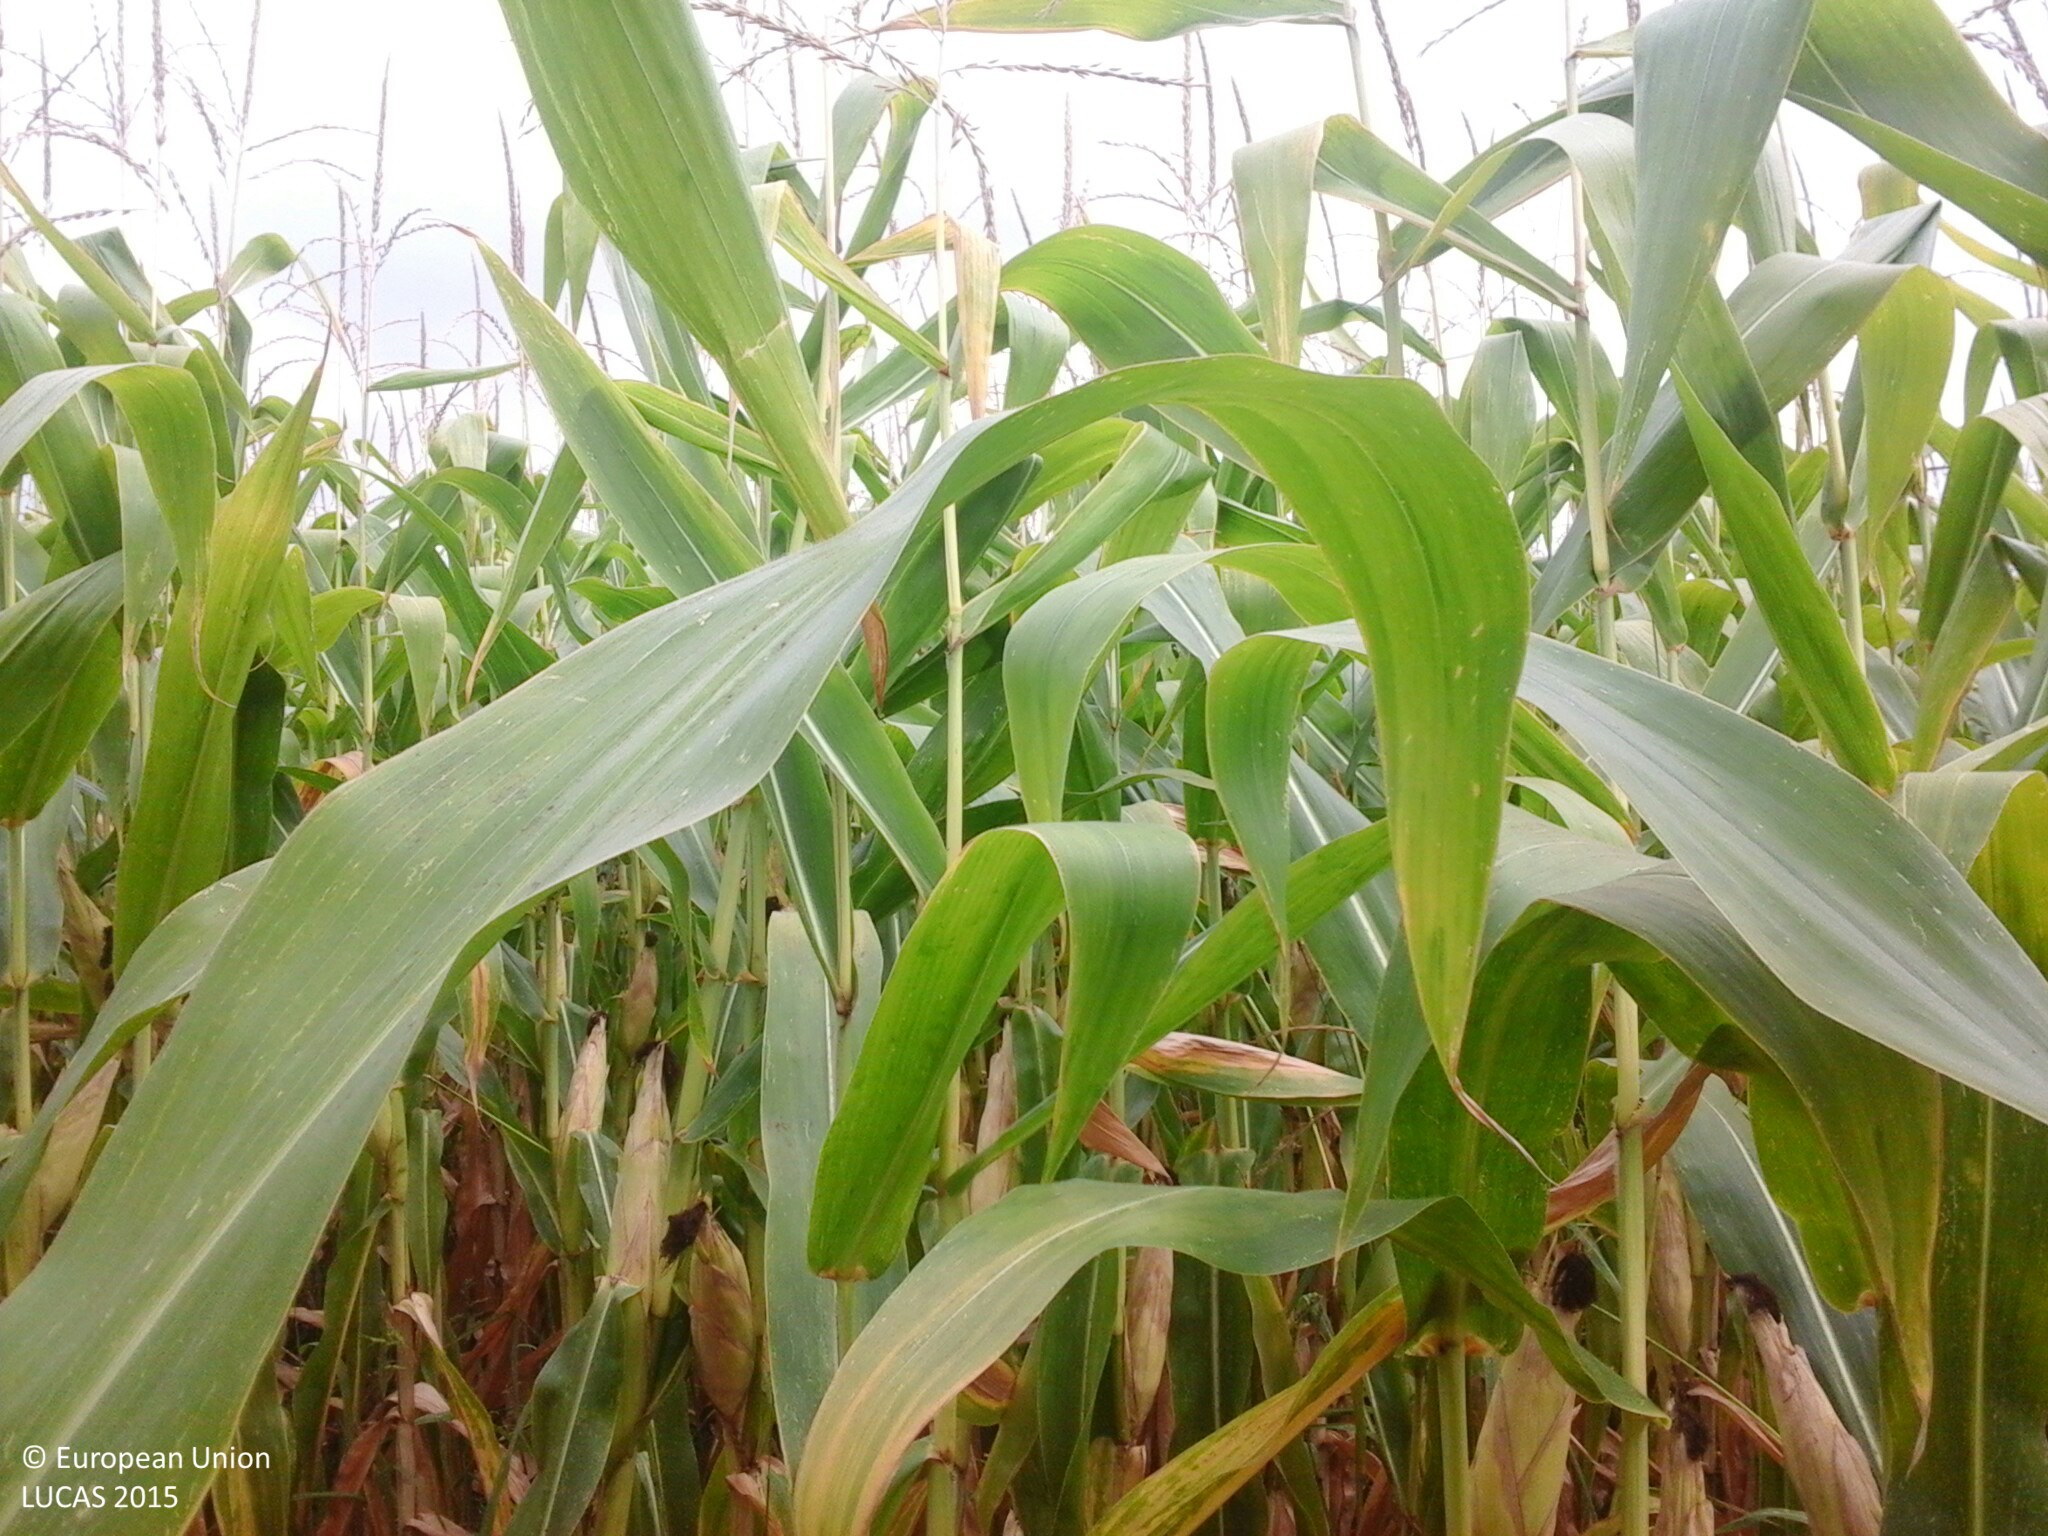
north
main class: Cropland
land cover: Maize
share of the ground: > 75 %
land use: Agriculture (excluding fallow land and kitchen gardens)
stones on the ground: < 10 %
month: August
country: HU
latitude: 46.9814
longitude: 21.5175
